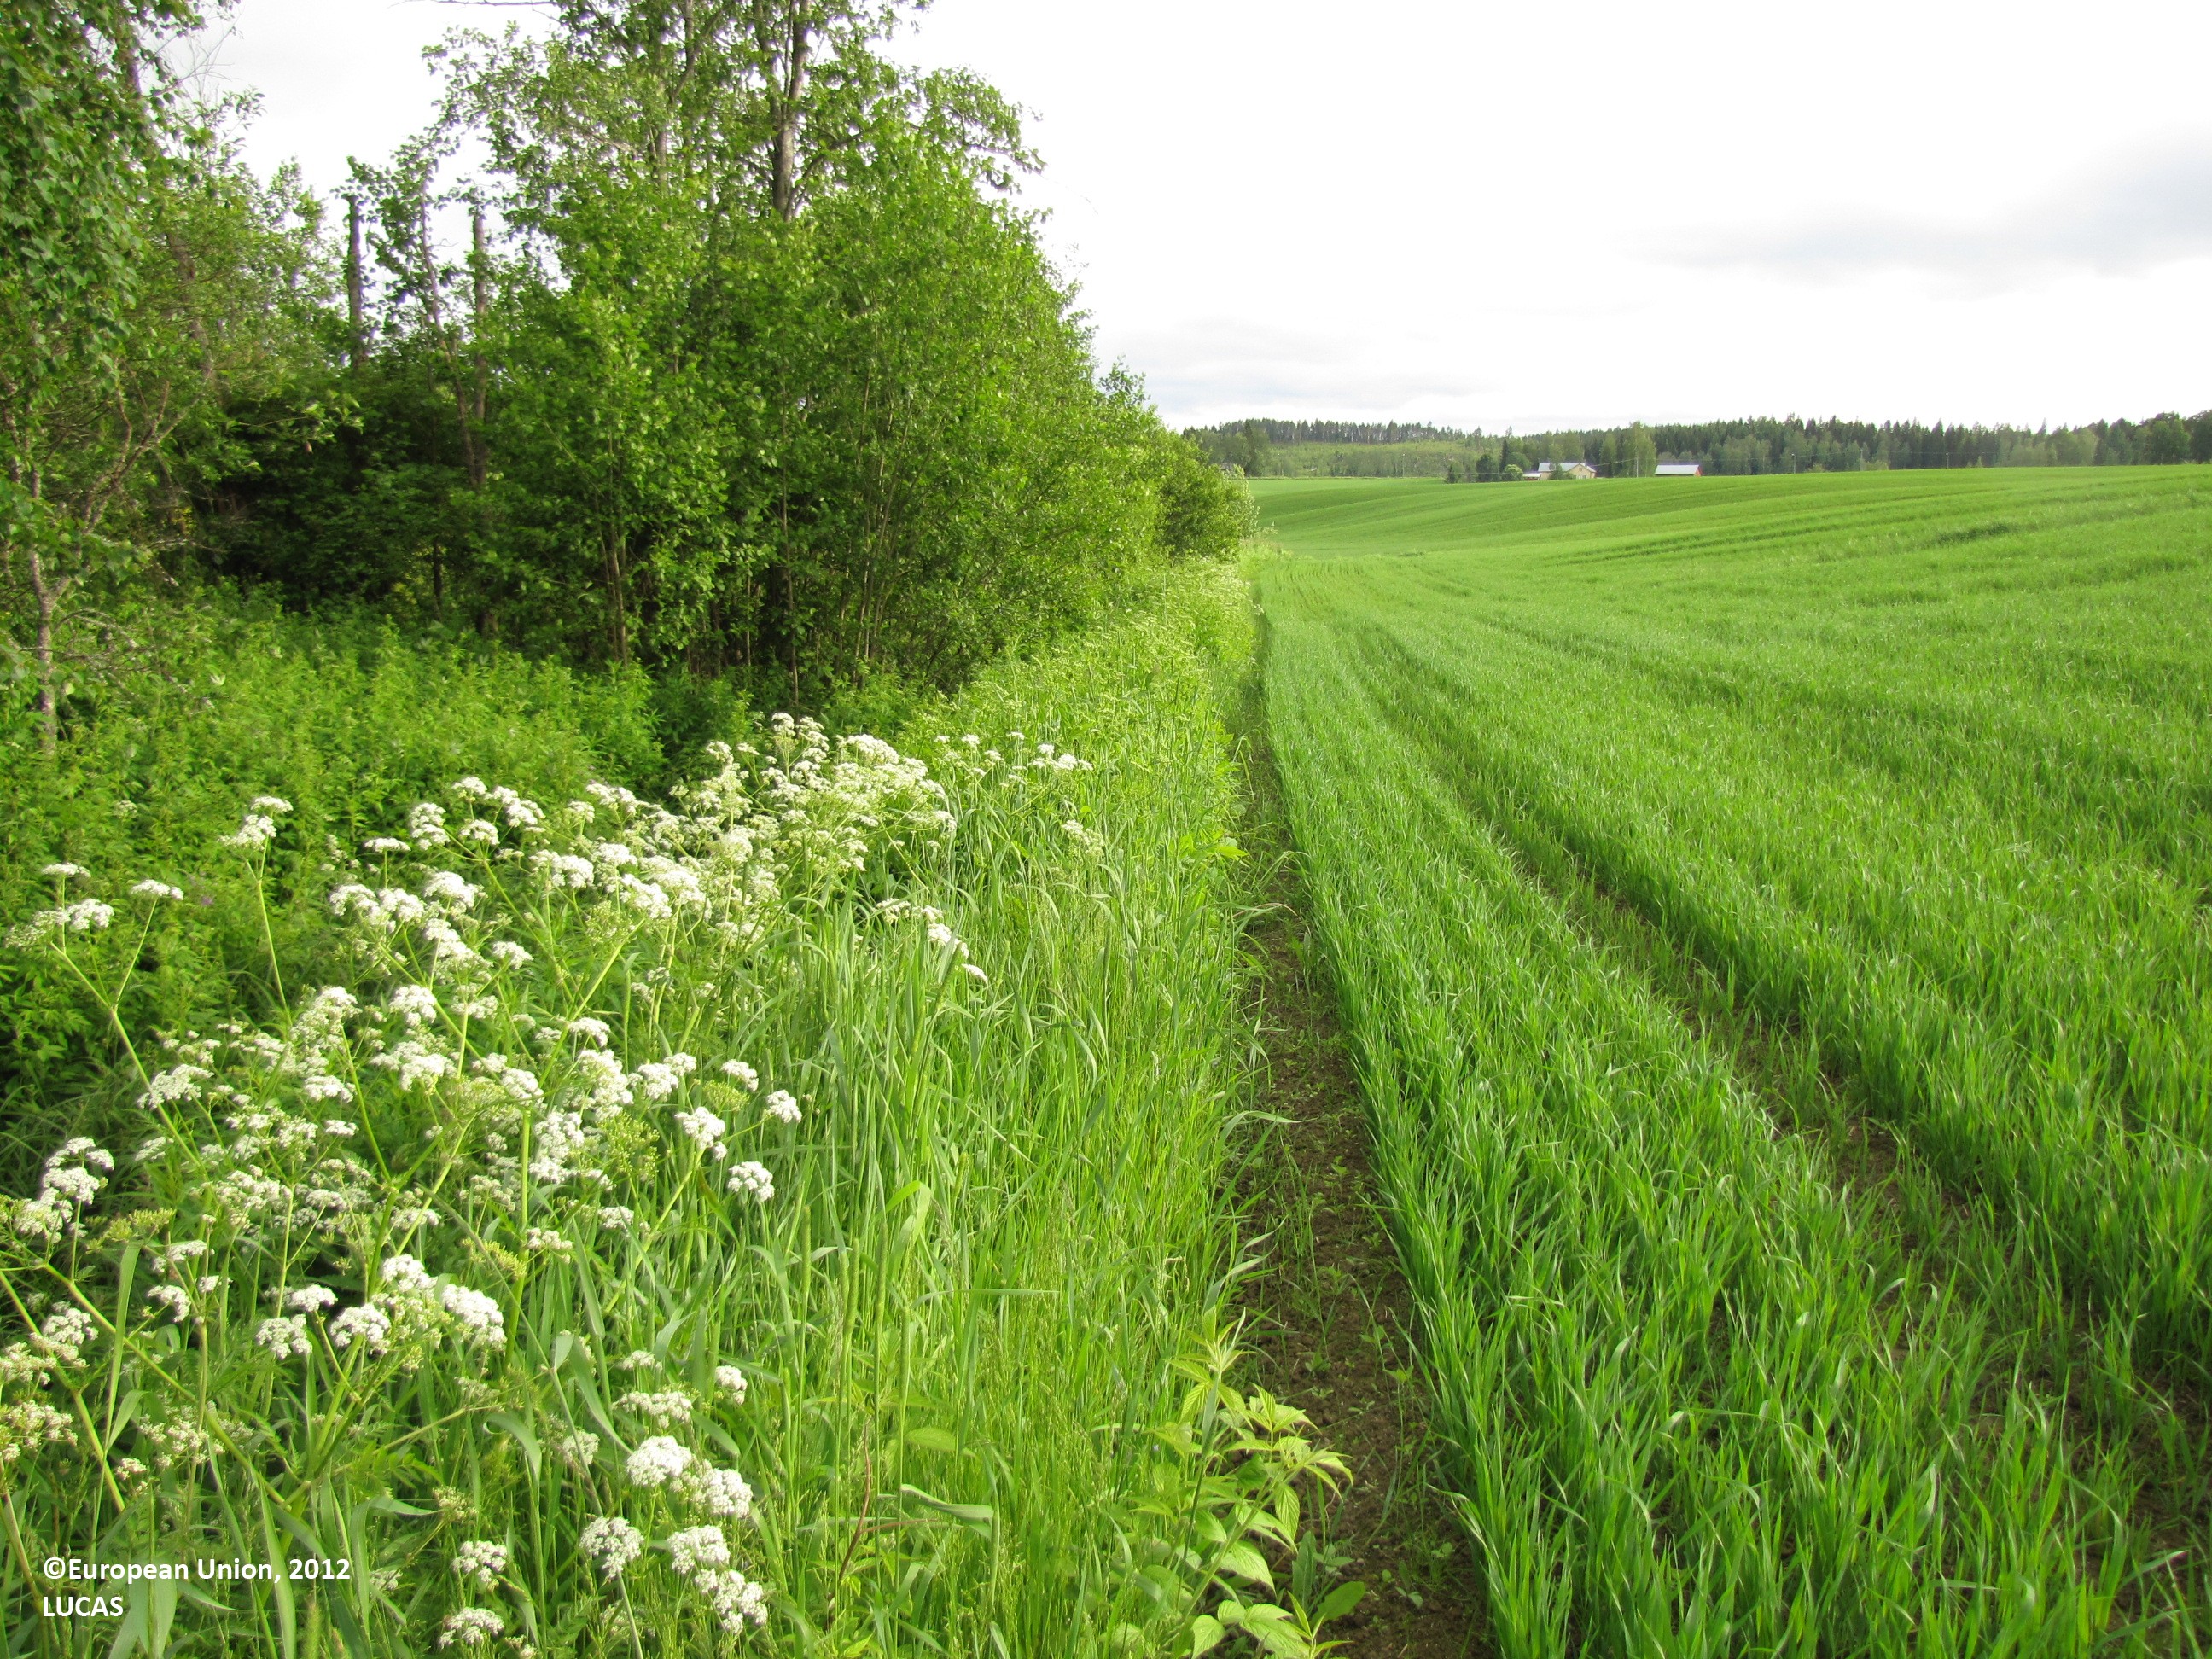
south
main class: Cropland
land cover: Oats
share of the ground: 50 - 75 %
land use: Agriculture (excluding fallow land and kitchen gardens)
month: June
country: FI
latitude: 61.7993
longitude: 24.4547
